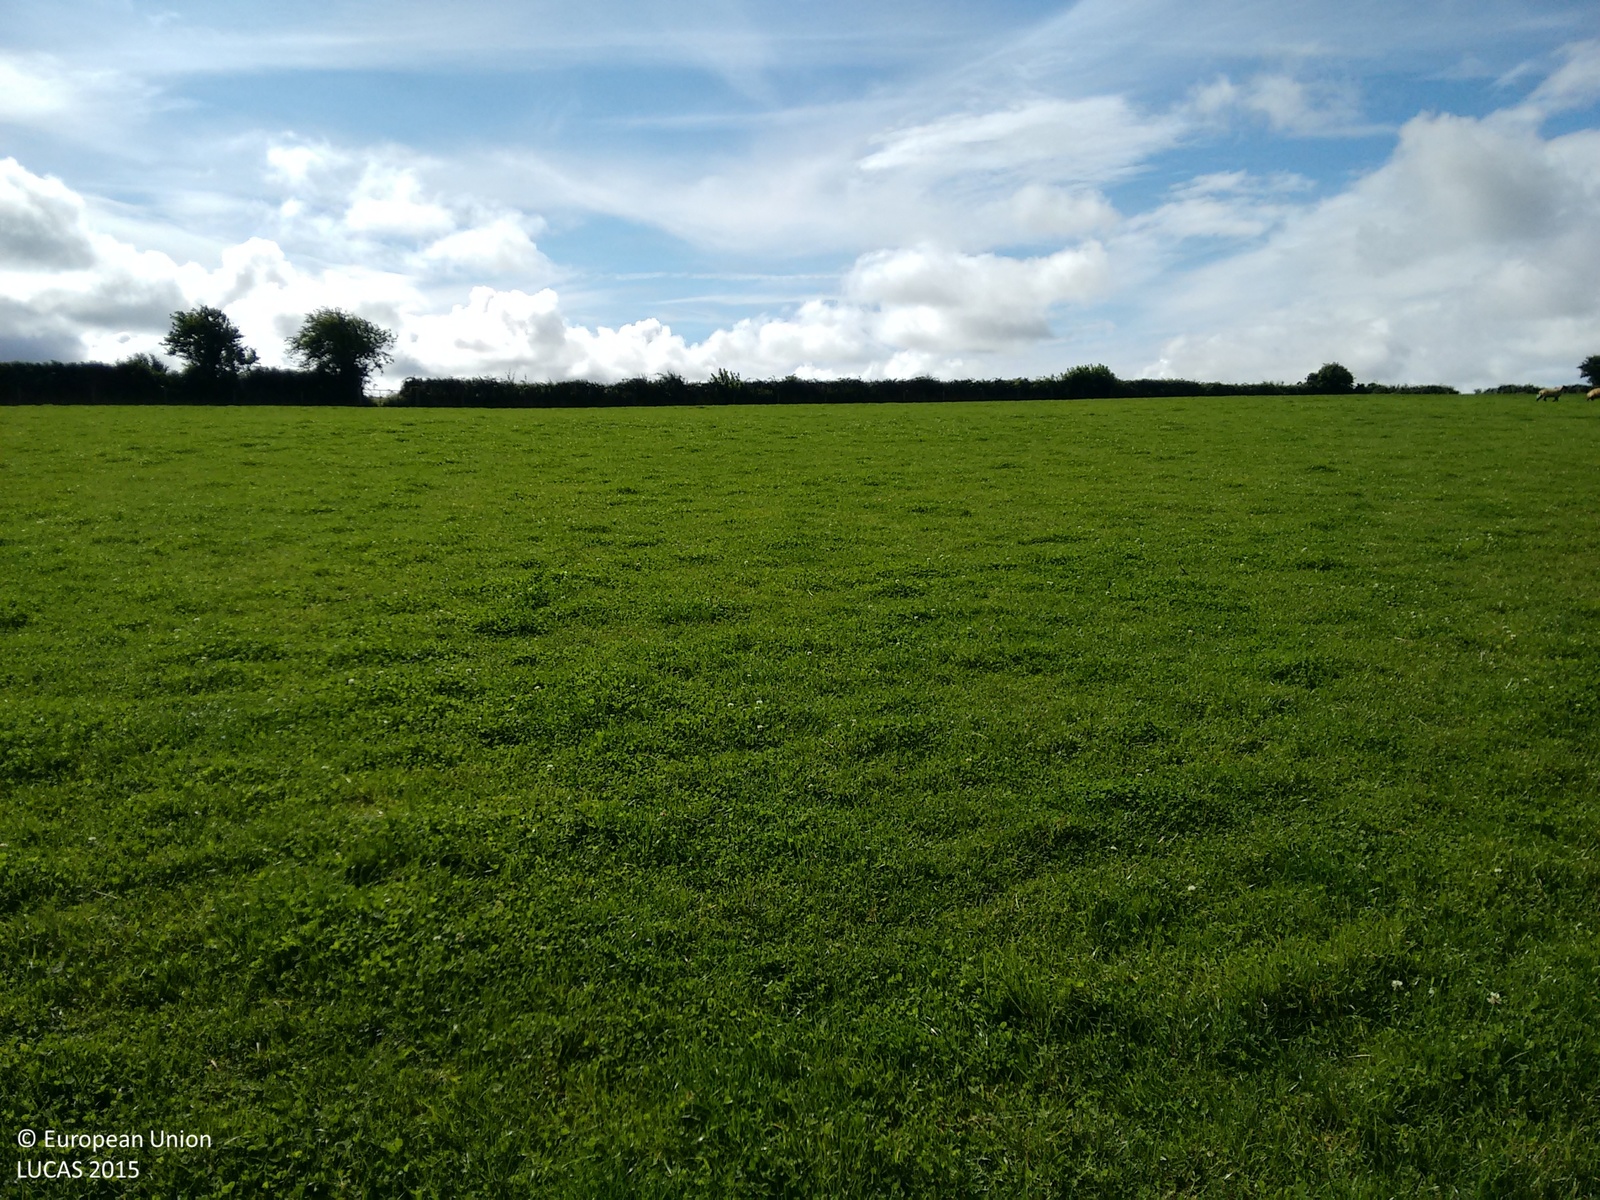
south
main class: Grassland
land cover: Grassland without tree/shrub cover
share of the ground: > 75 %
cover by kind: herbaceous plants 100 %
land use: Agriculture (excluding fallow land and kitchen gardens)
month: August
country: IE
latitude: 52.3868
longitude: -6.6320
